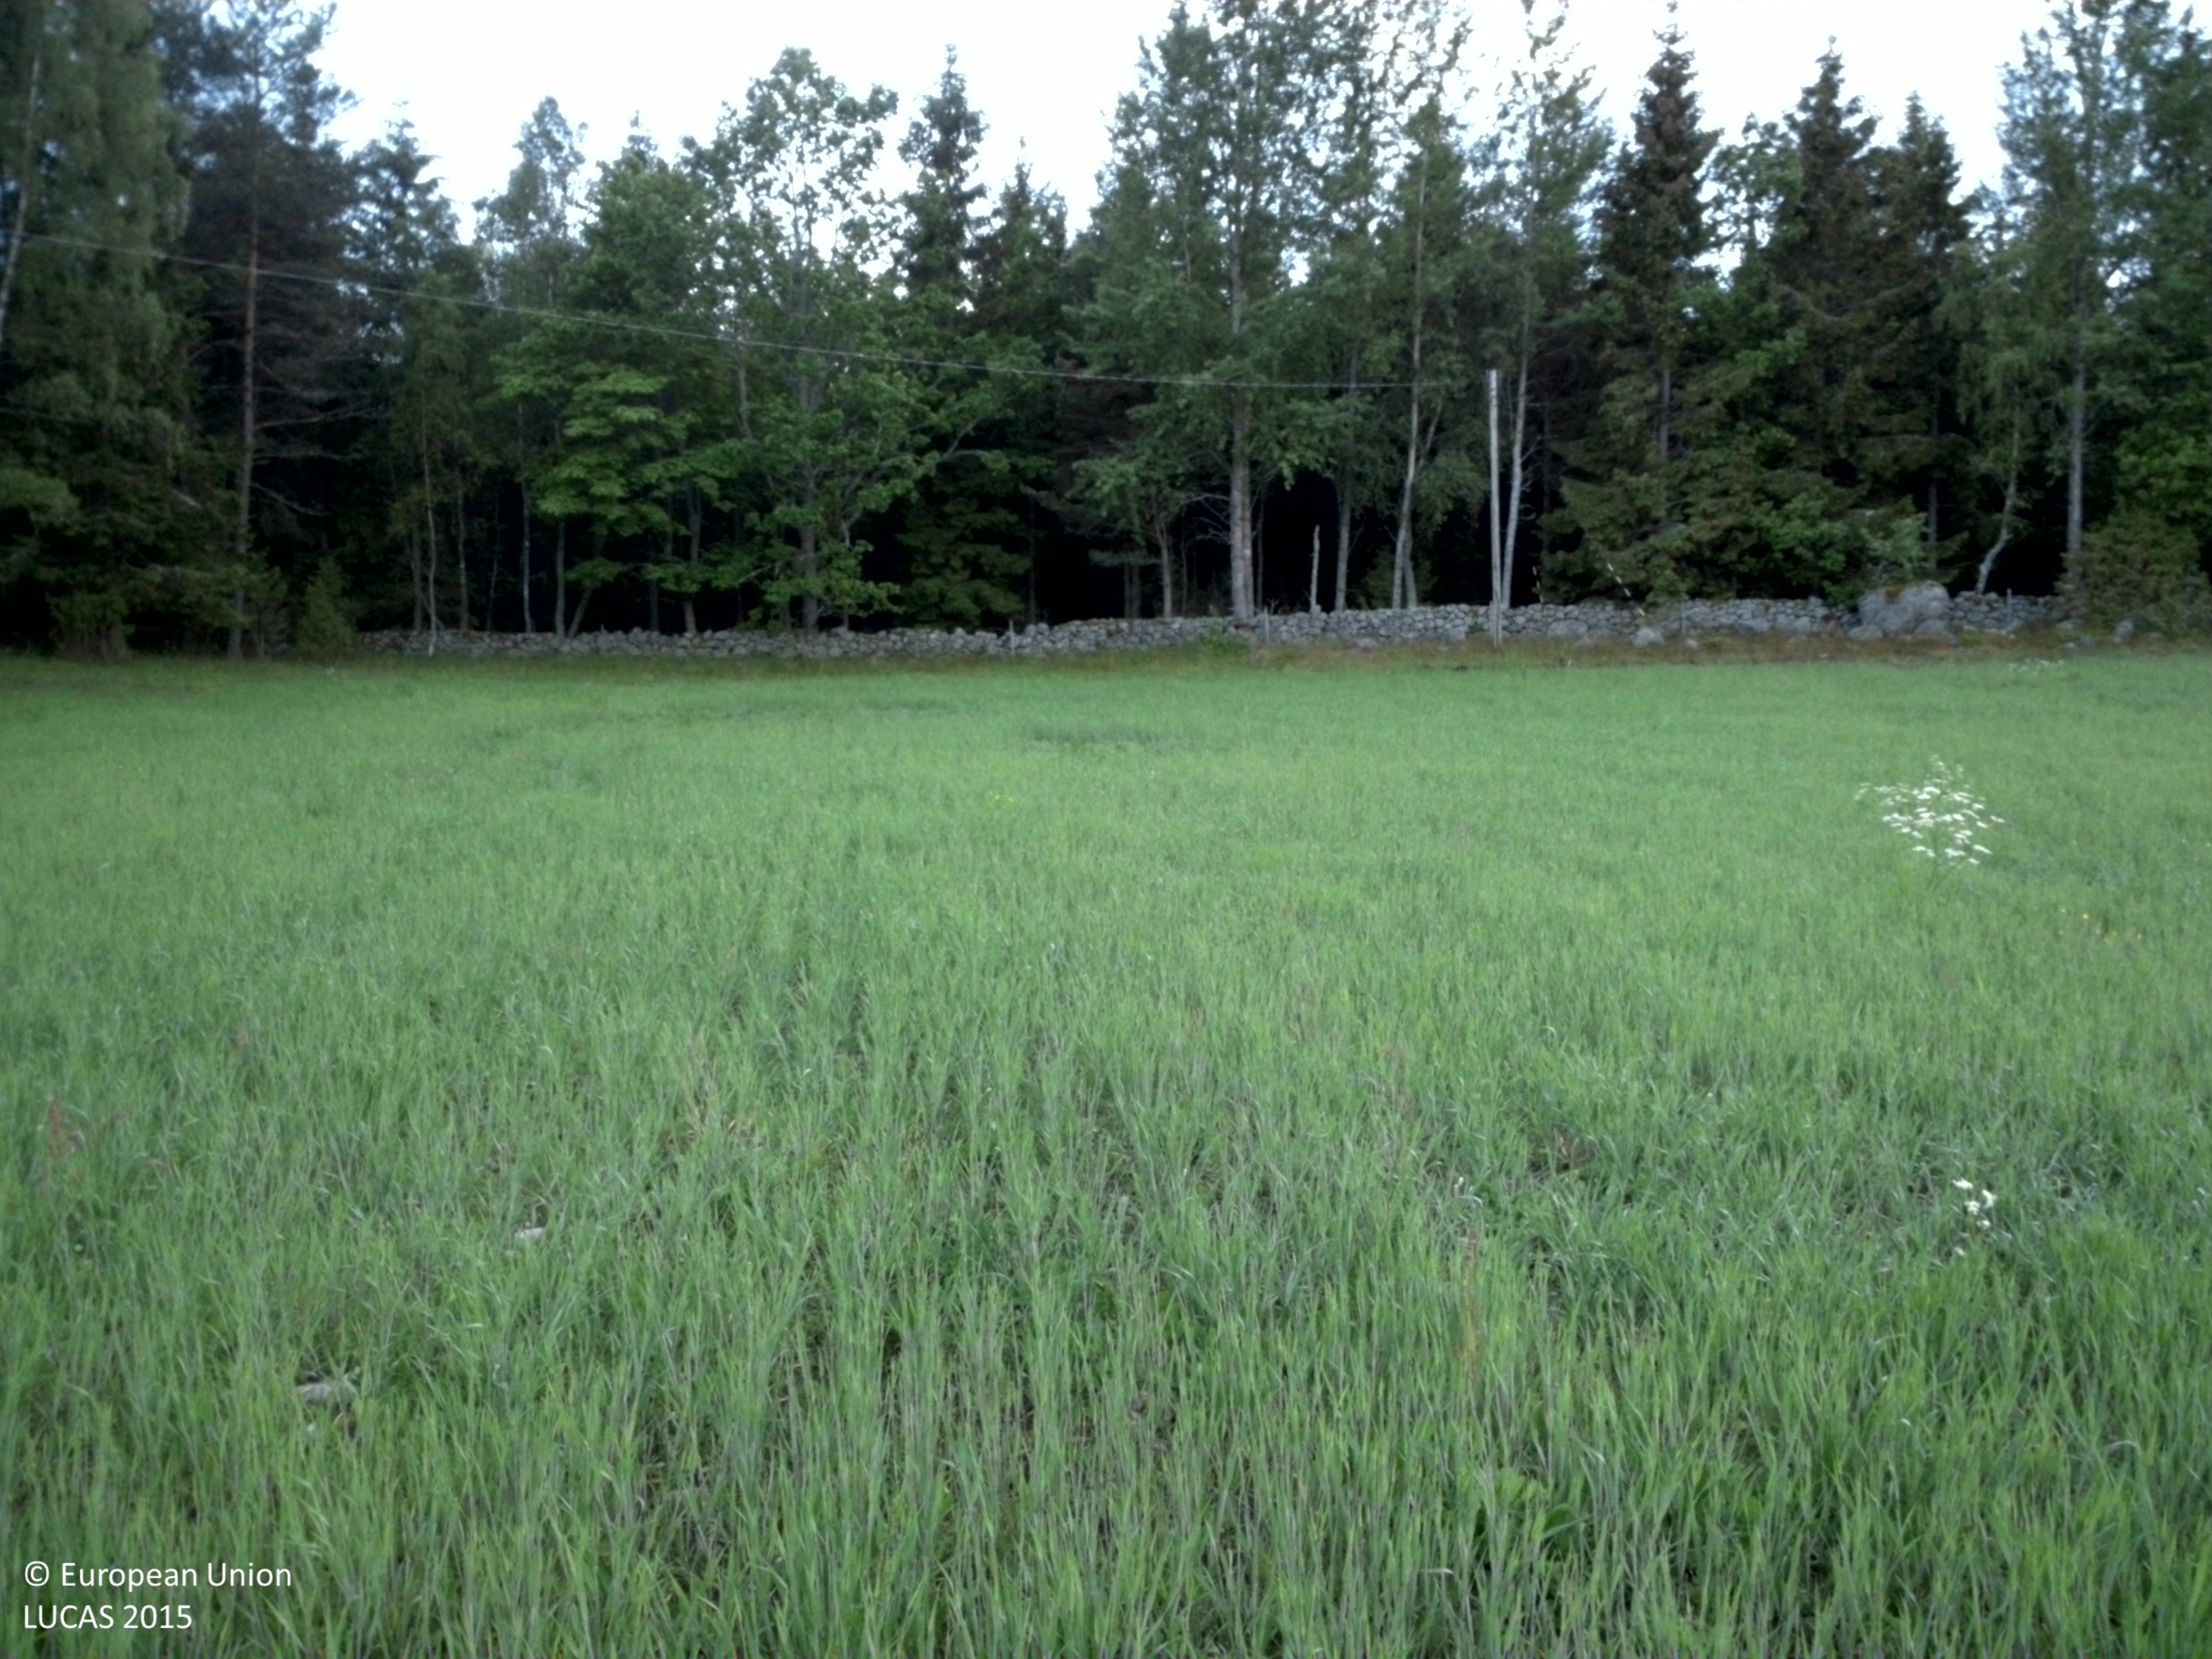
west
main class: Cropland
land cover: Barley
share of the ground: > 75 %
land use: Agriculture (excluding fallow land and kitchen gardens)
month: June
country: SE
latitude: 58.2777
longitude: 14.2739
